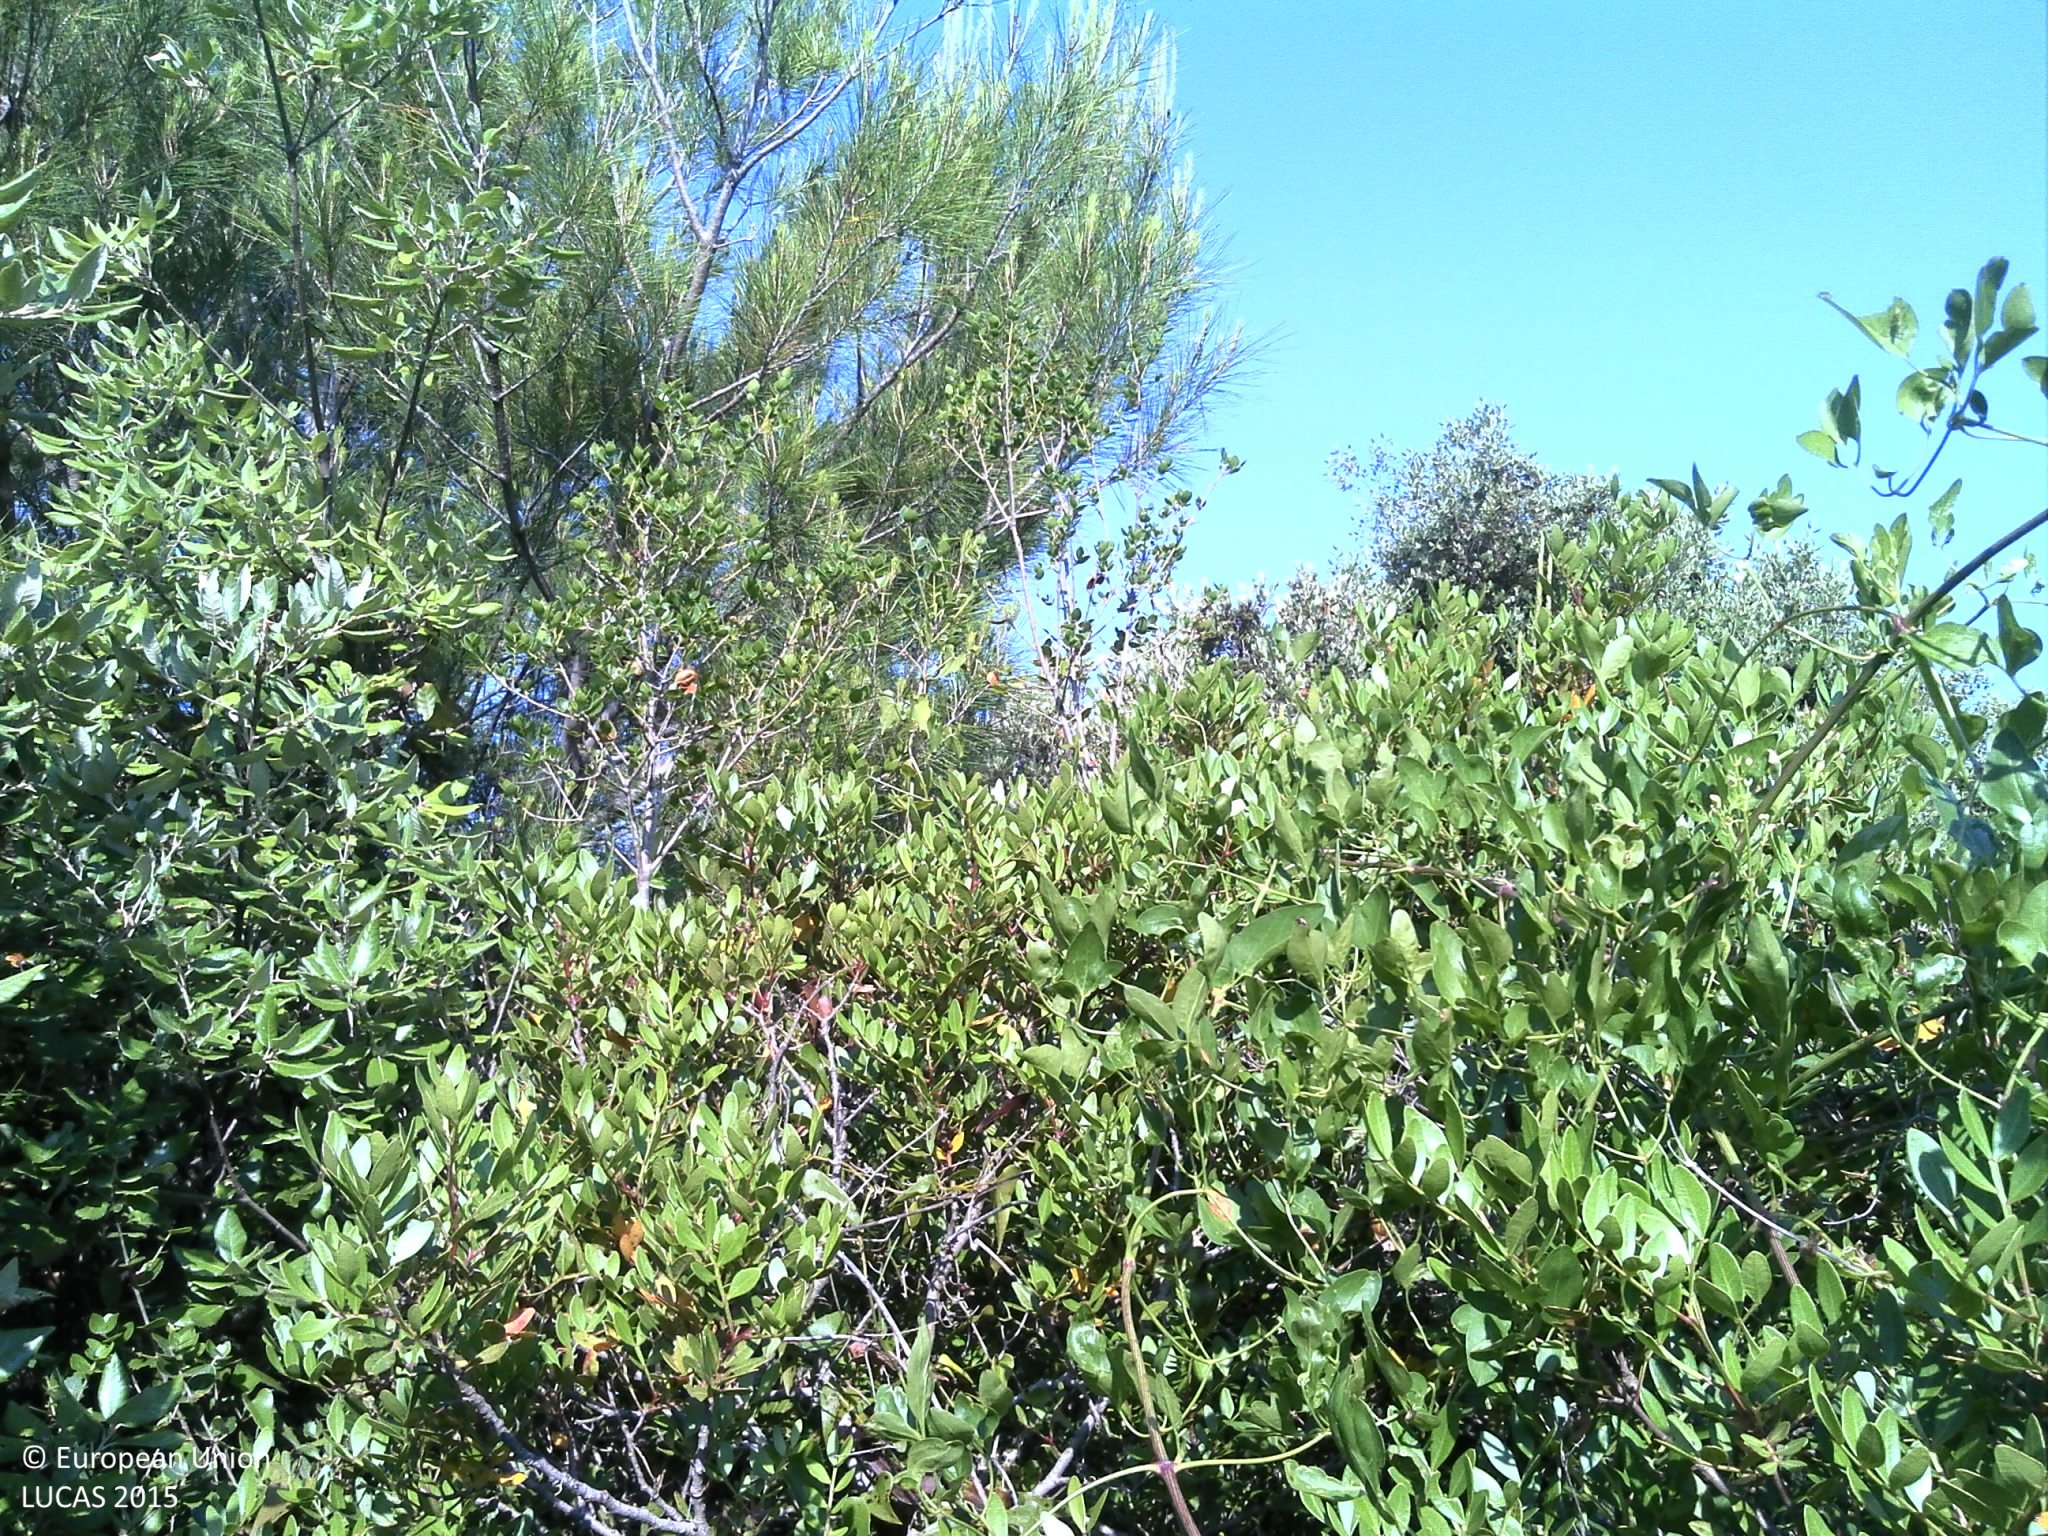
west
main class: Shrubland
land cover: Shrubland with sparse tree cover
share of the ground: > 75 %
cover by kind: shrubs 80 %, coniferous forest trees 5 %, herbaceous plants 5 %, consolidated bare surface 5 %, unconsolidated bare surface 5 %
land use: Semi-natural and natural areas not in use
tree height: < 5 m
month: June
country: HR
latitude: 43.5220
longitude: 16.0650
